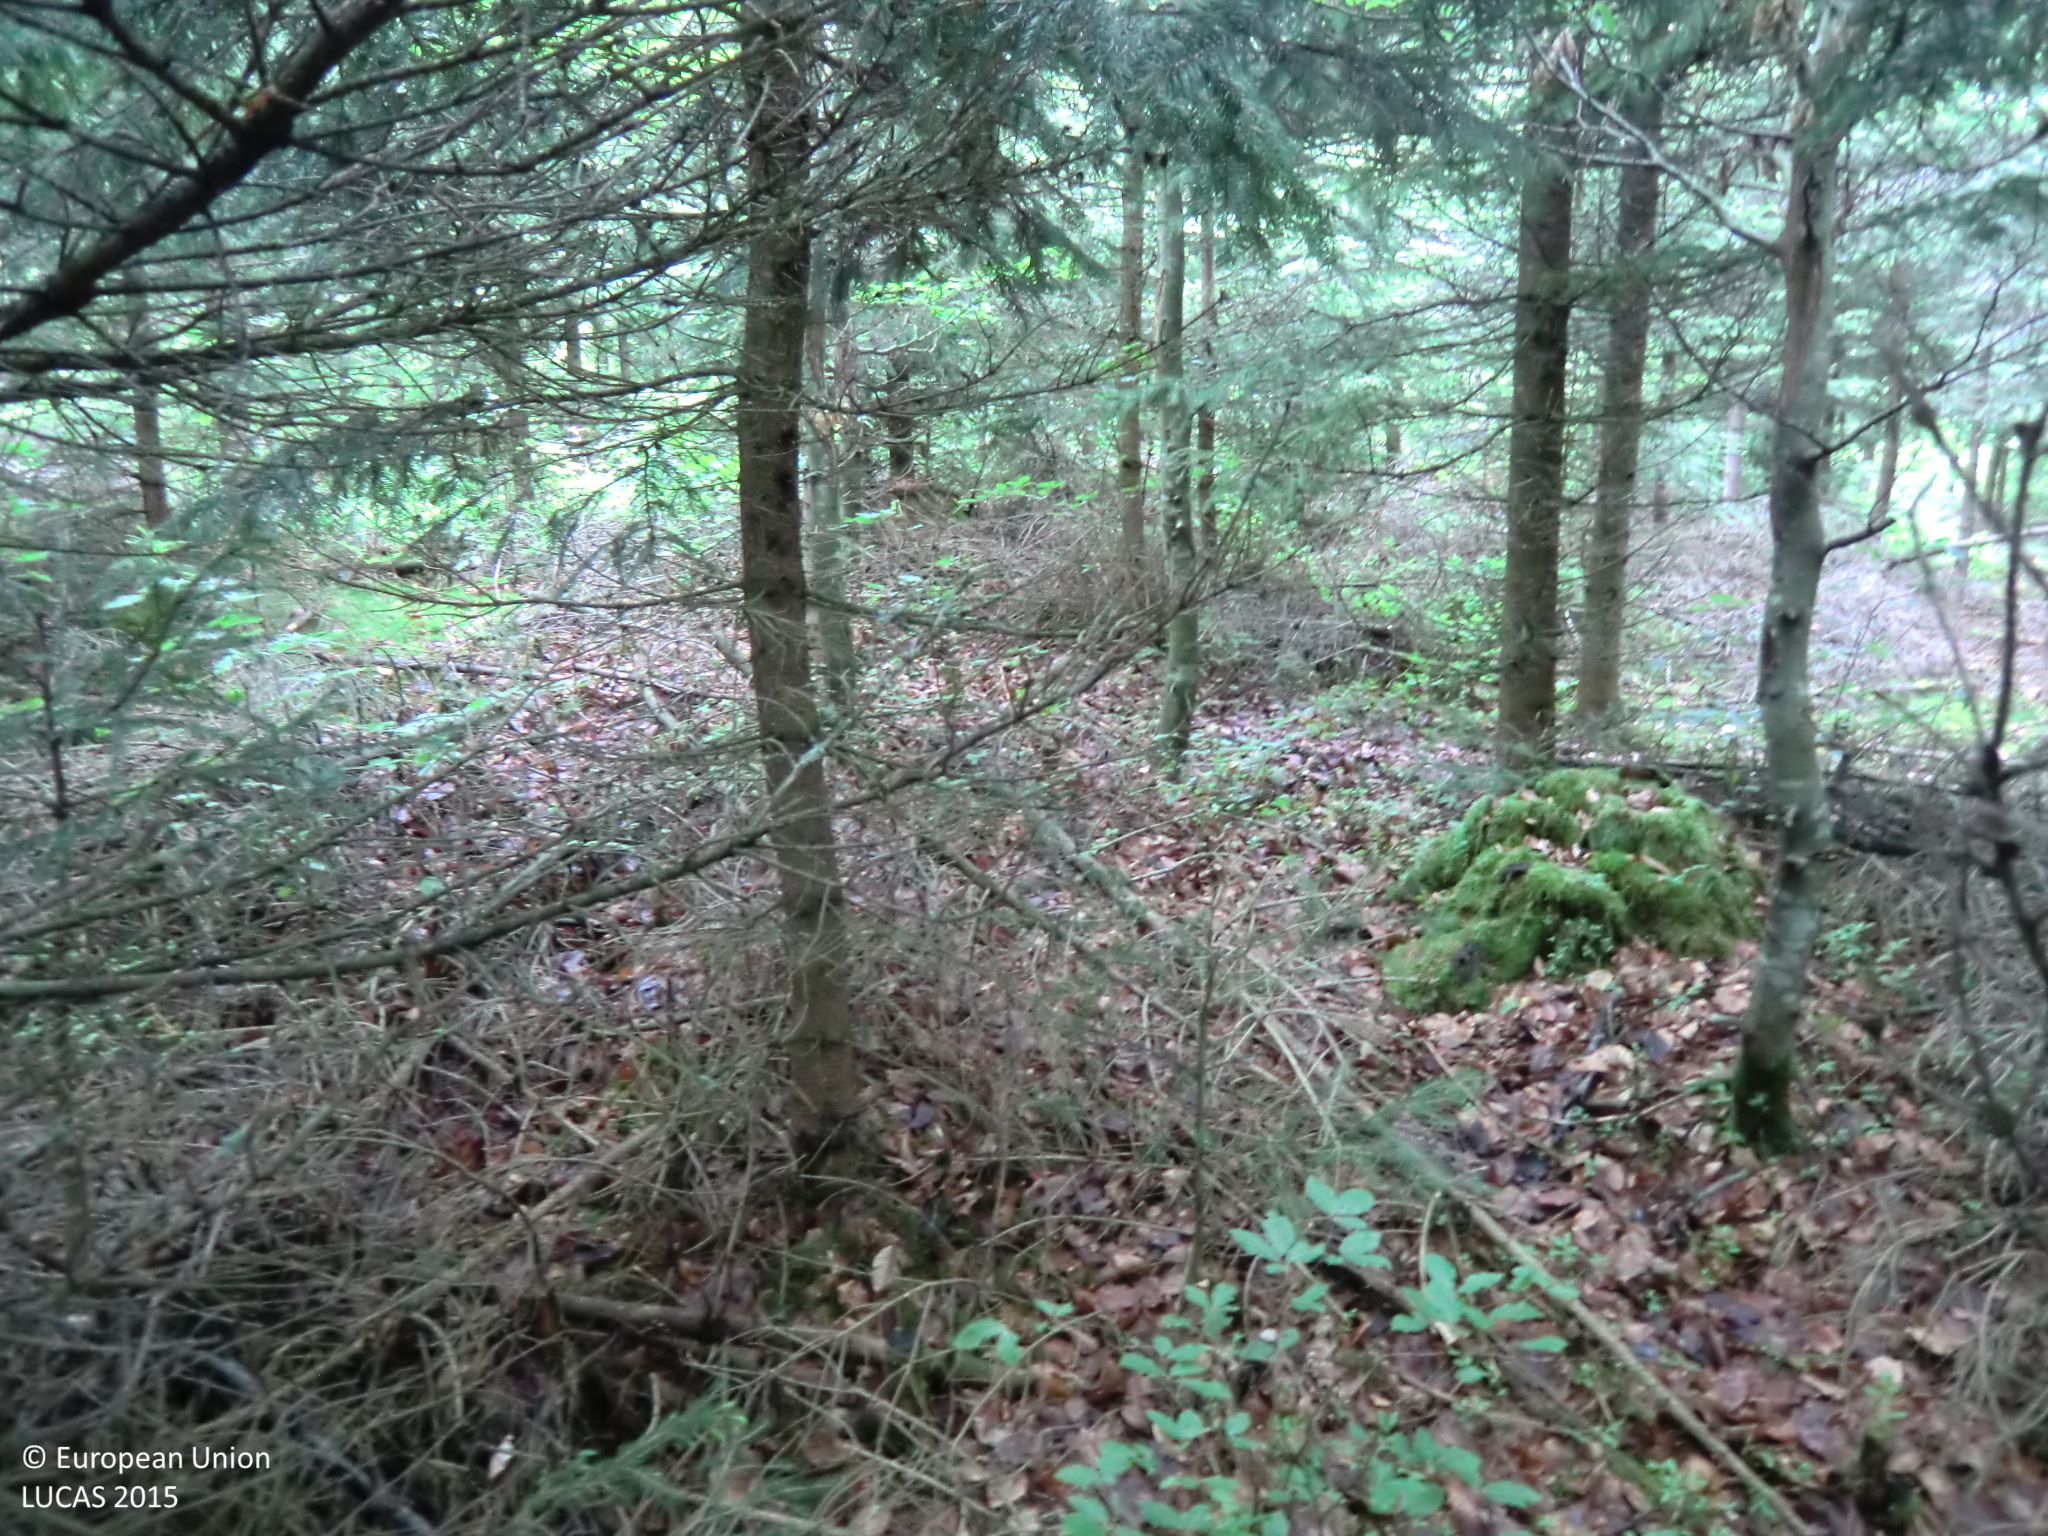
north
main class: Woodland
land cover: Spruce dominated mixed woodland
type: hemiboreal forest and nemoral coniferous forest and mixed broadleaved-coniferous forest
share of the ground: > 75 %
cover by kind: coniferous forest trees 50 %, broadleaved forest trees 30 %, shrubs 20 %
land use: Forestry
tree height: > 5 m
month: May
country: AT
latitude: 48.3992
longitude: 14.9855
